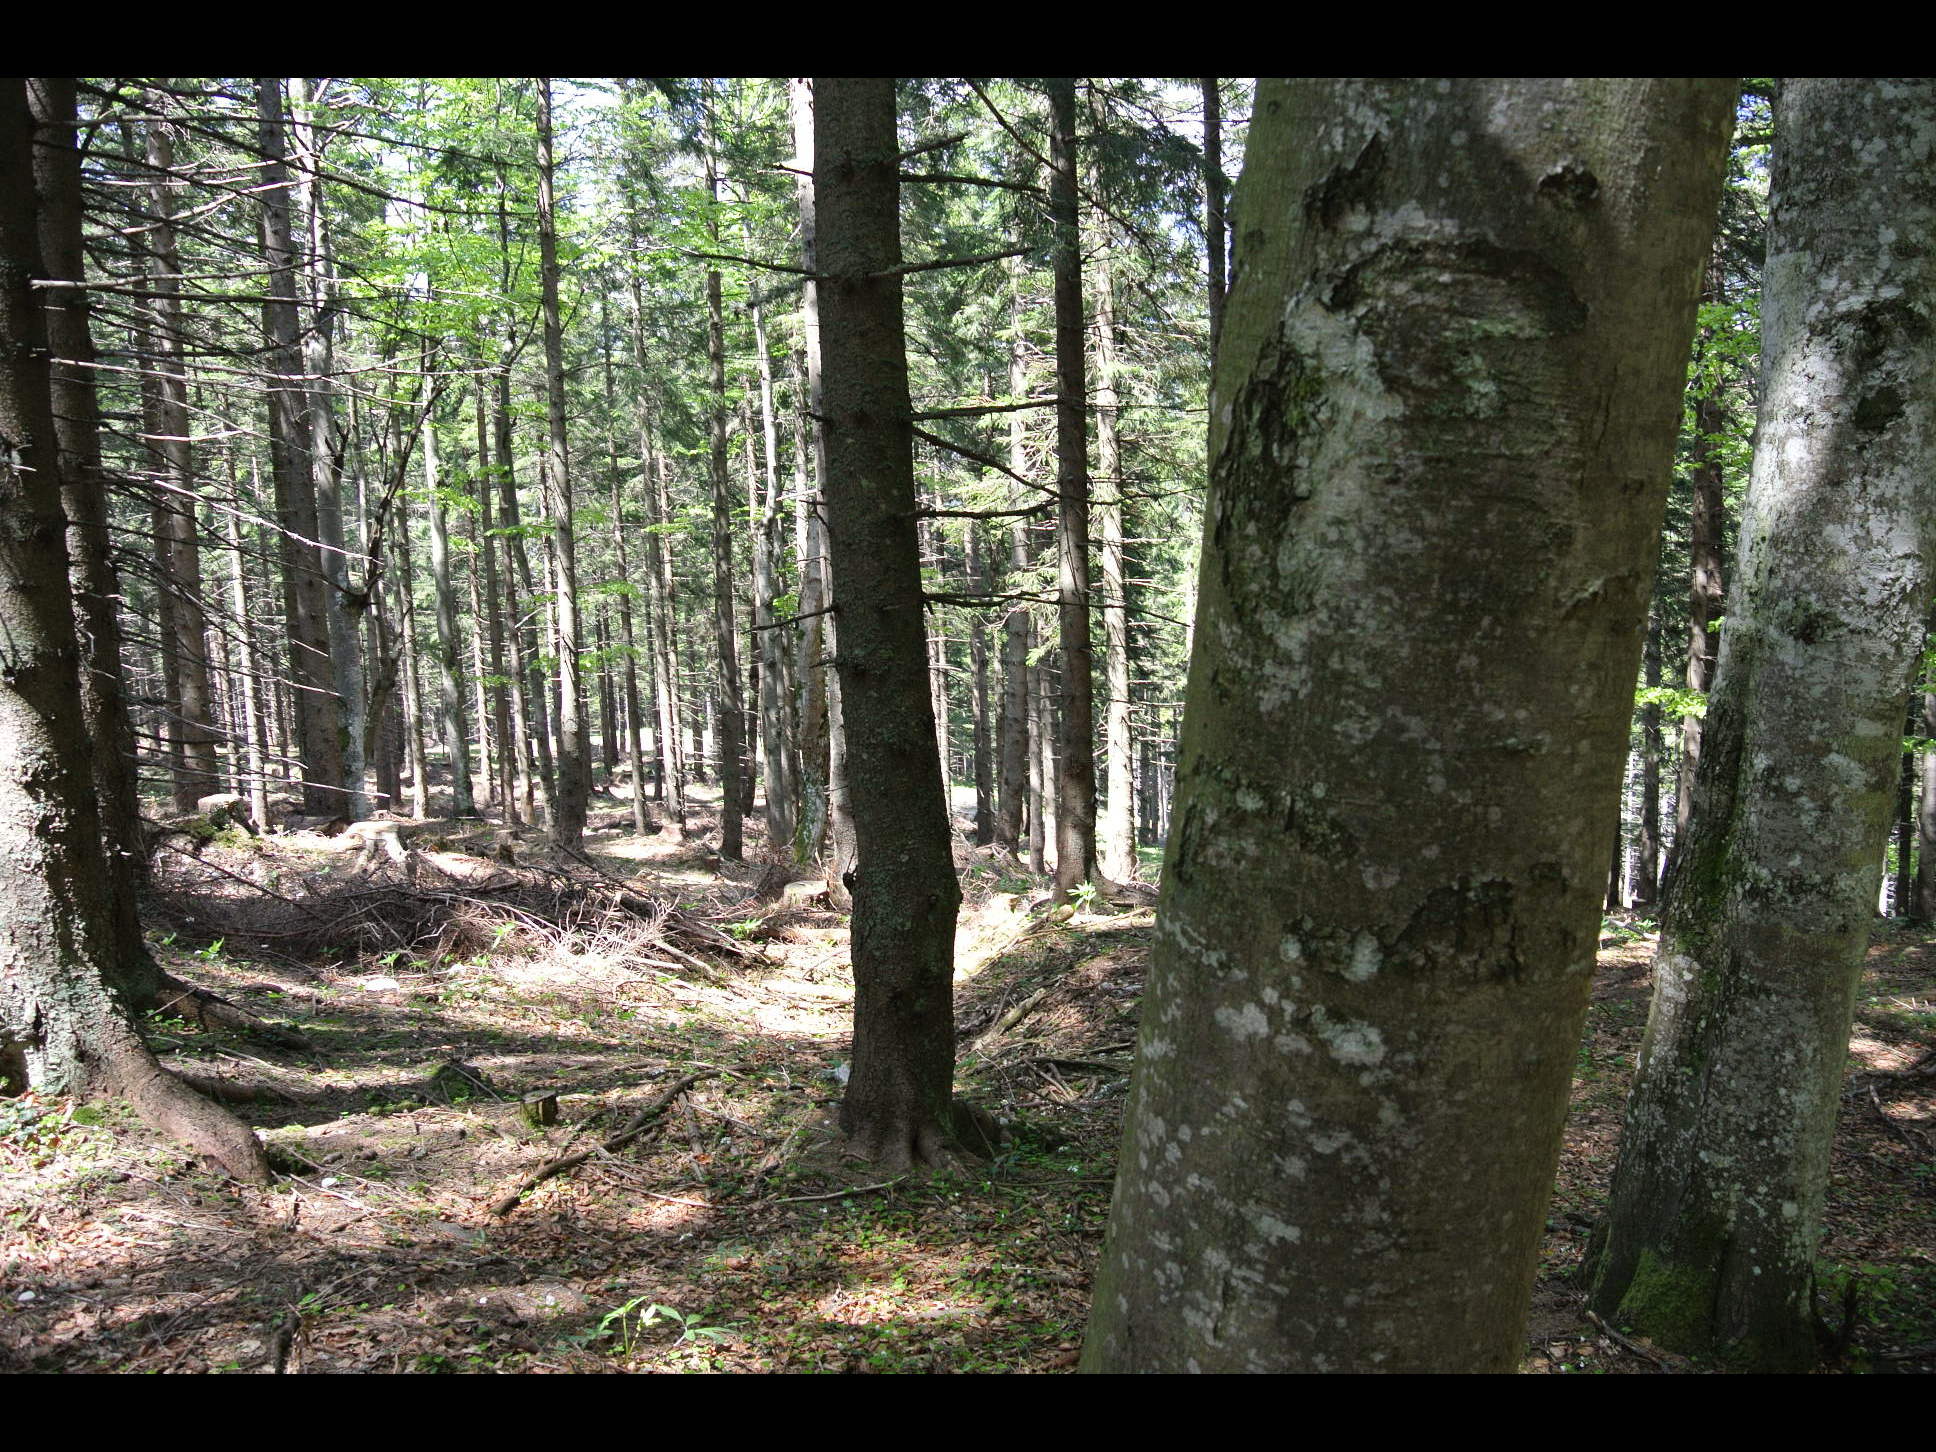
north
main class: Woodland
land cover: Spruce dominated mixed woodland
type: alpine coniferous forest
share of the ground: > 75 %
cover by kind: coniferous forest trees 70 %, broadleaved forest trees 30 %
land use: Forestry
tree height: > 5 m
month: May
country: AT
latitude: 47.7266
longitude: 15.8285
